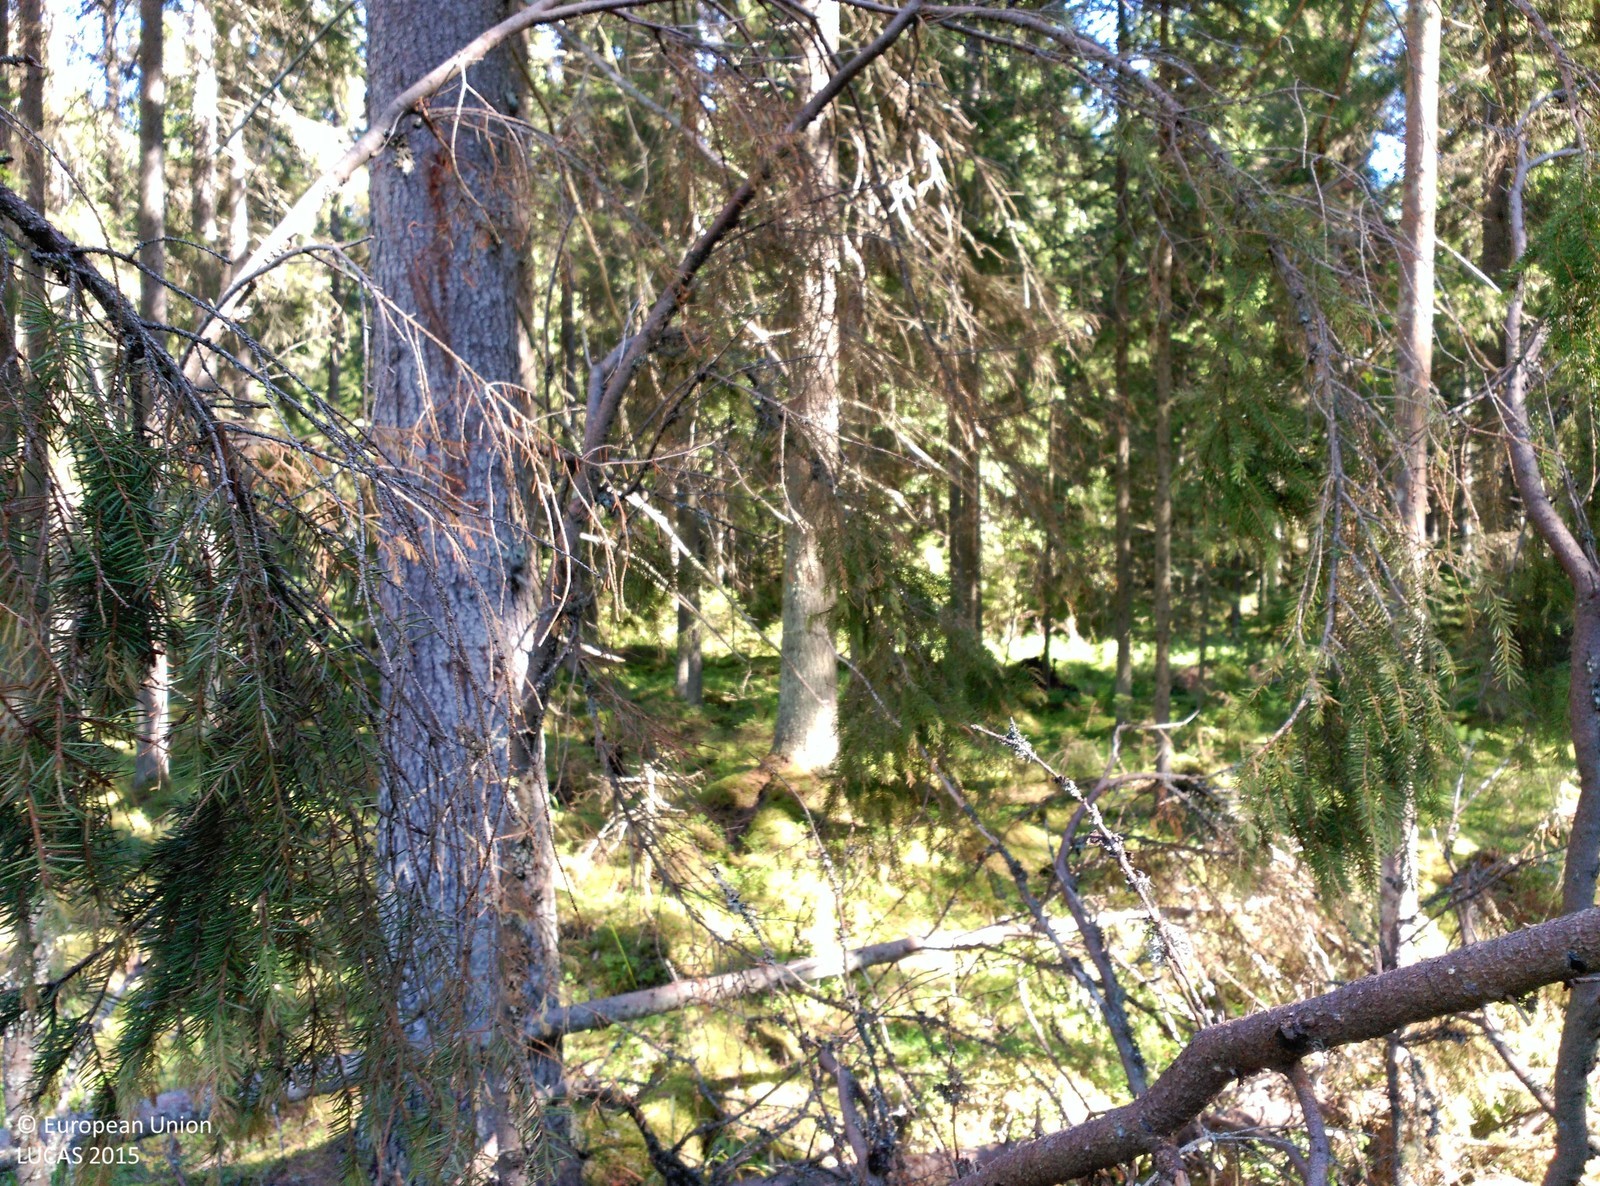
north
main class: Woodland
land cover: Spruce dominated coniferous woodland
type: hemiboreal forest and nemoral coniferous forest and mixed broadleaved-coniferous forest
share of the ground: 50 - 75 %
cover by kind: coniferous forest trees 65 %, lichens and mosses 25 %, shrubs 10 %
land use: Forestry
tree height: > 5 m
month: August
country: FI
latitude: 61.0506
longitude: 22.8697
